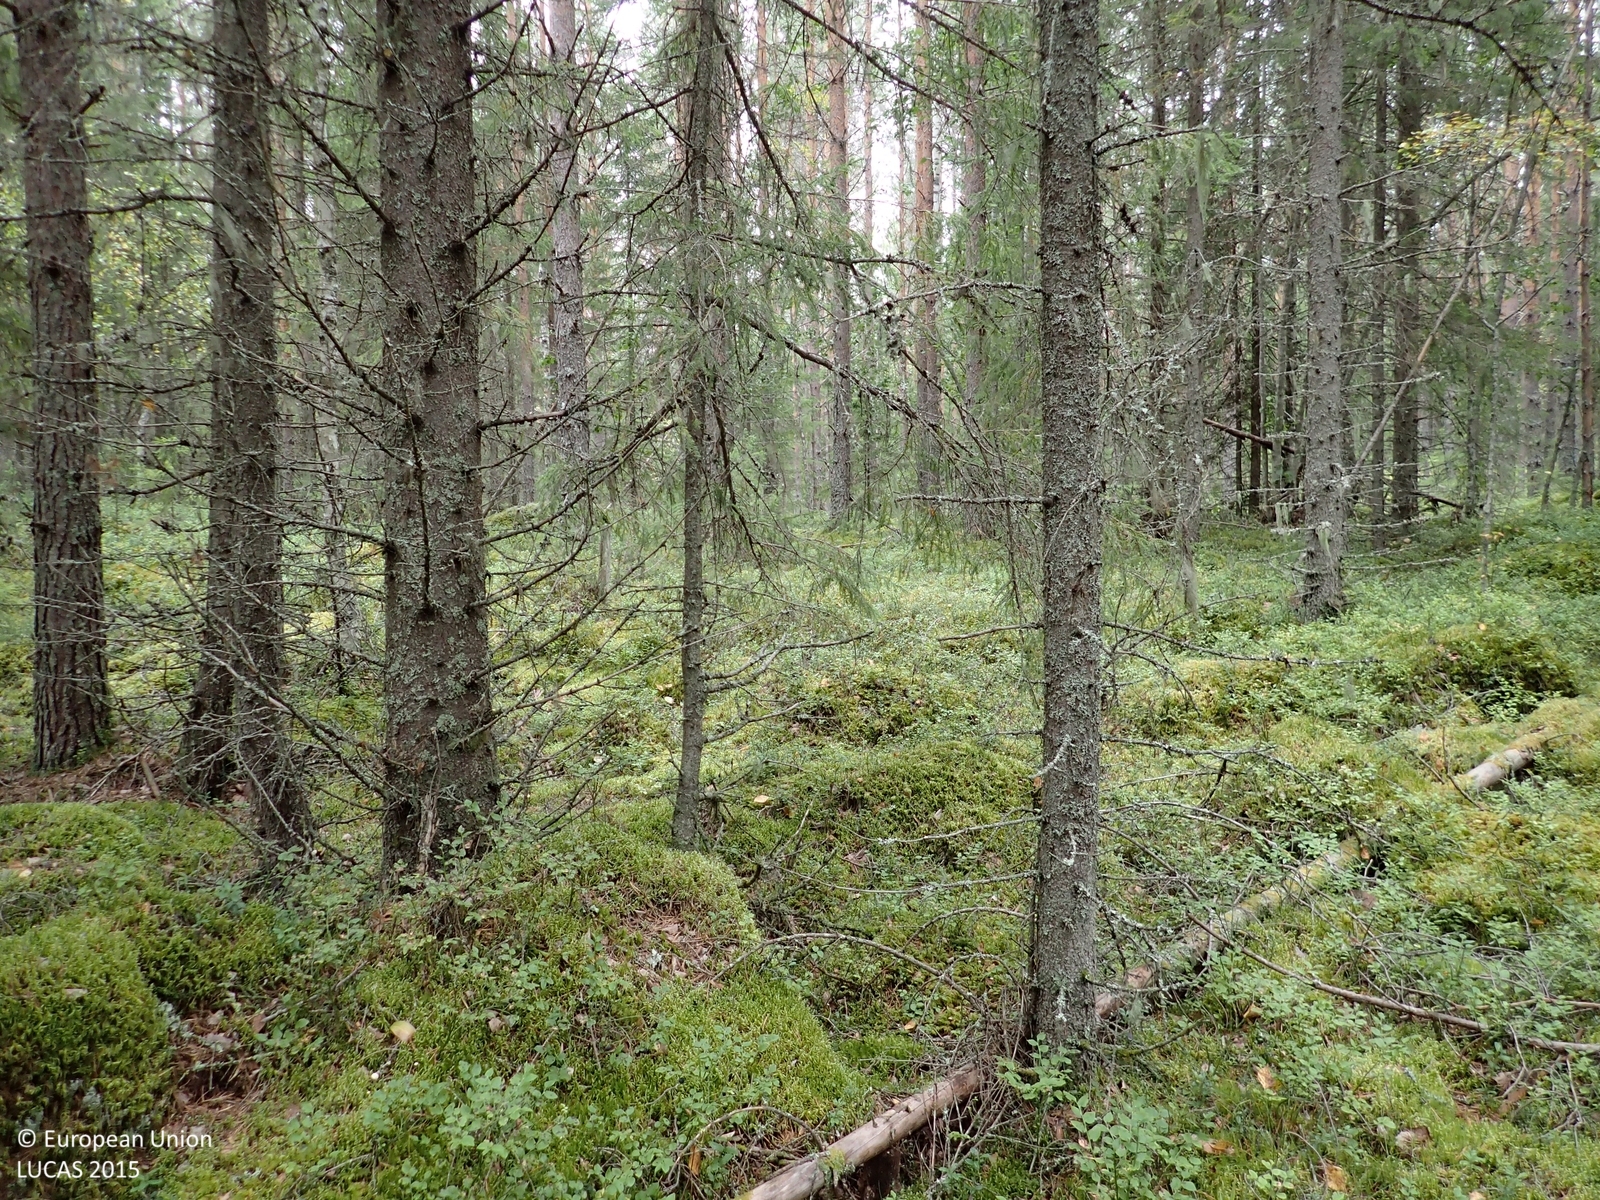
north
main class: Woodland
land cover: Other coniferous woodland
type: boreal forest
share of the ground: > 75 %
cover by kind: coniferous forest trees 70 %, broadleaved forest trees 10 %, shrubs 10 %, lichens and mosses 10 %
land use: Forestry
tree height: > 5 m
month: September
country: FI
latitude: 62.9616
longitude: 25.7089
